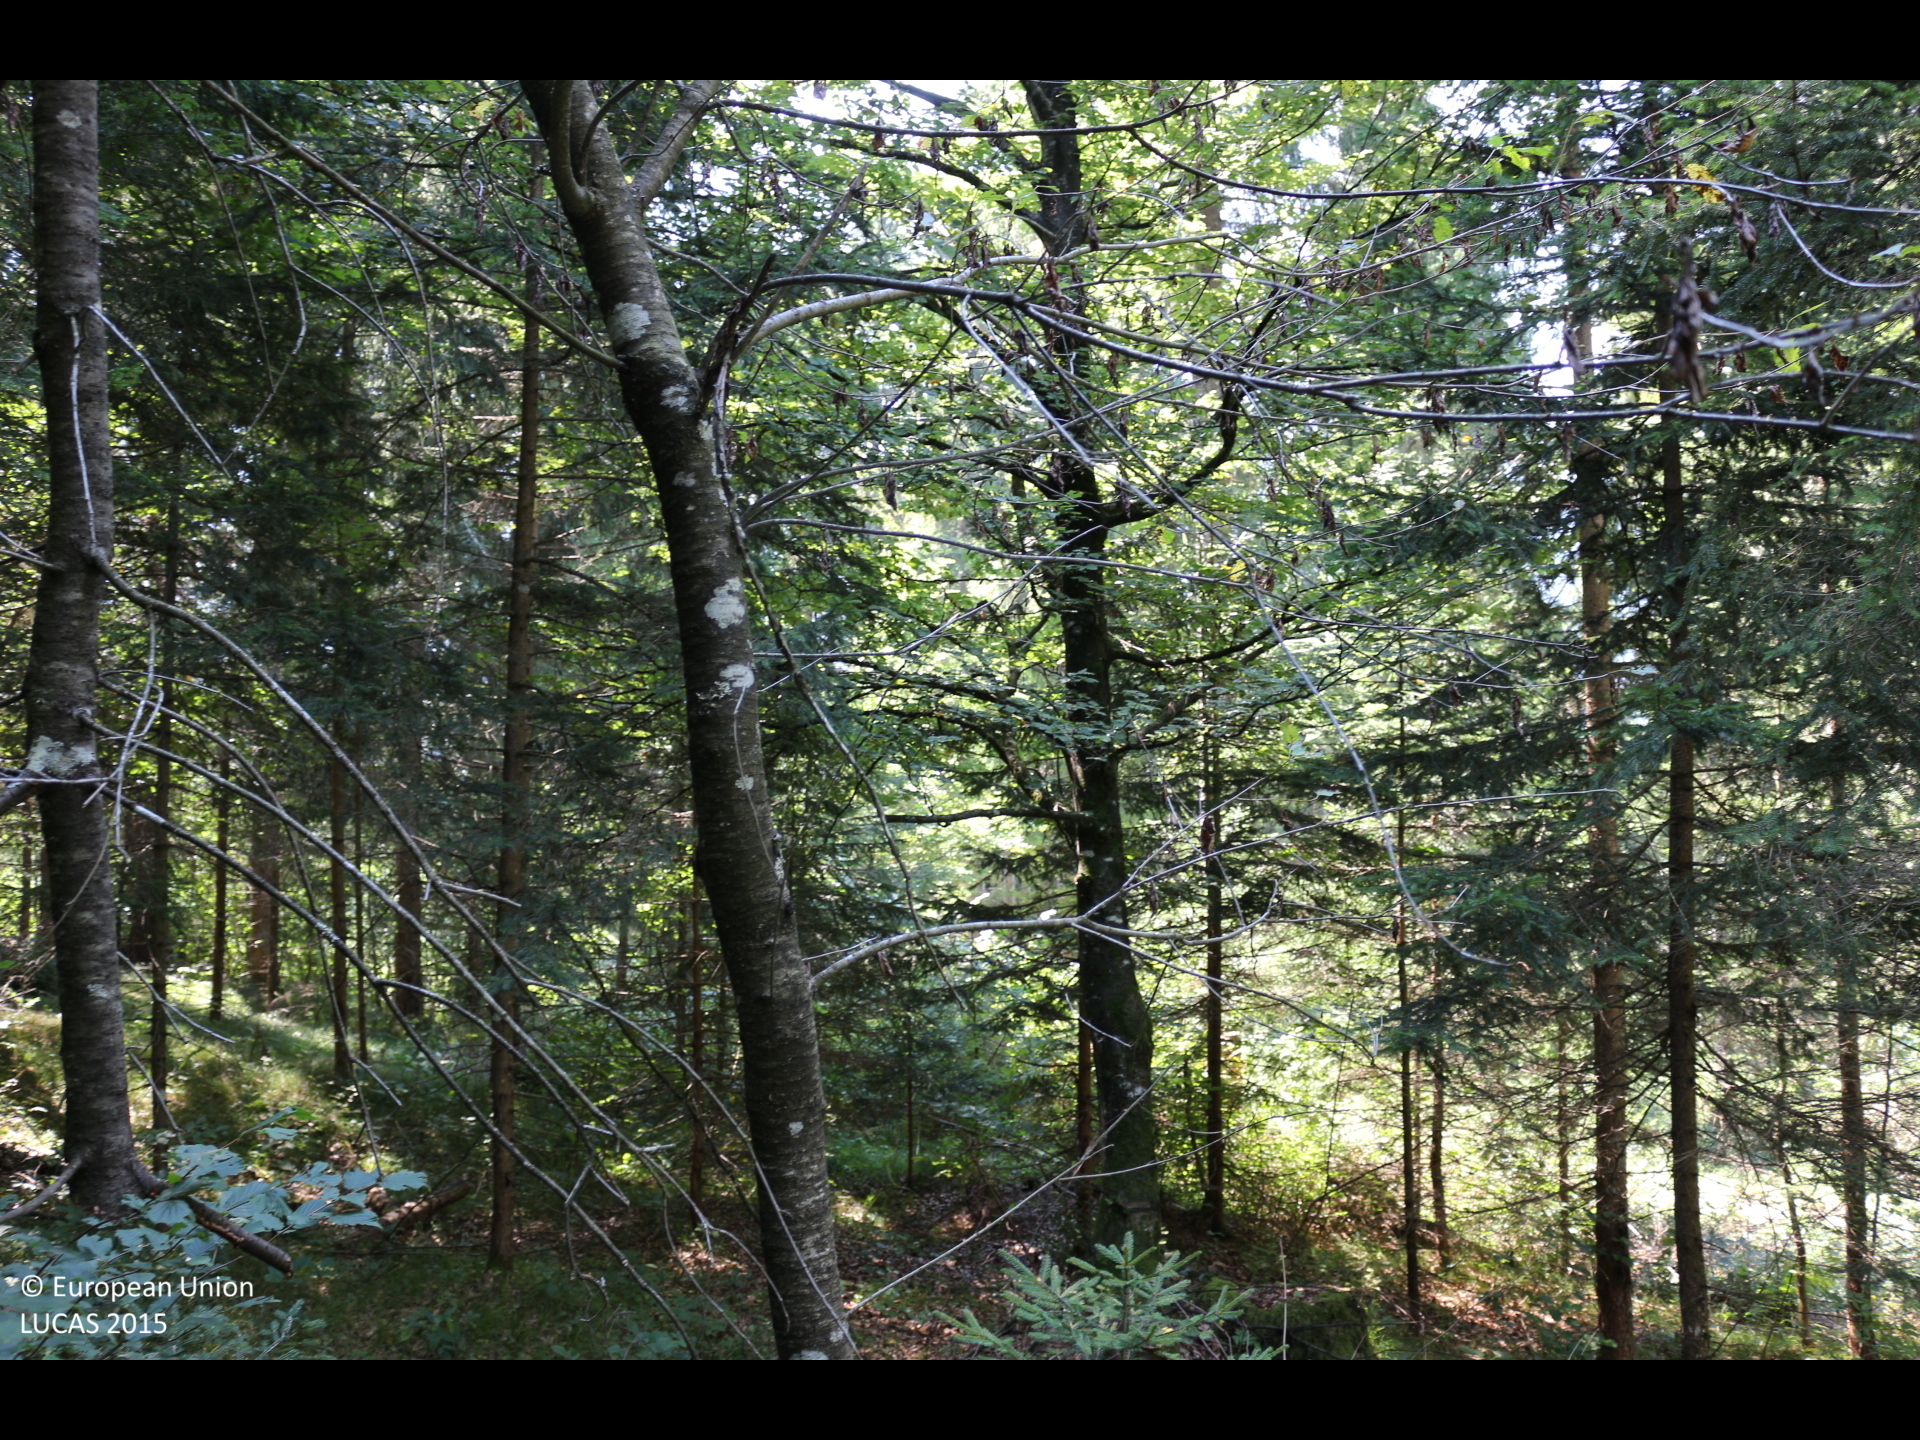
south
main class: Woodland
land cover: Spruce dominated mixed woodland
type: alpine coniferous forest
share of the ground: > 75 %
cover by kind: coniferous forest trees 65 %, broadleaved forest trees 25 %, shrubs 5 %, herbaceous plants 5 %
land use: Forestry
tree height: > 5 m
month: August
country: AT
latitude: 46.6795
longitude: 13.2787
